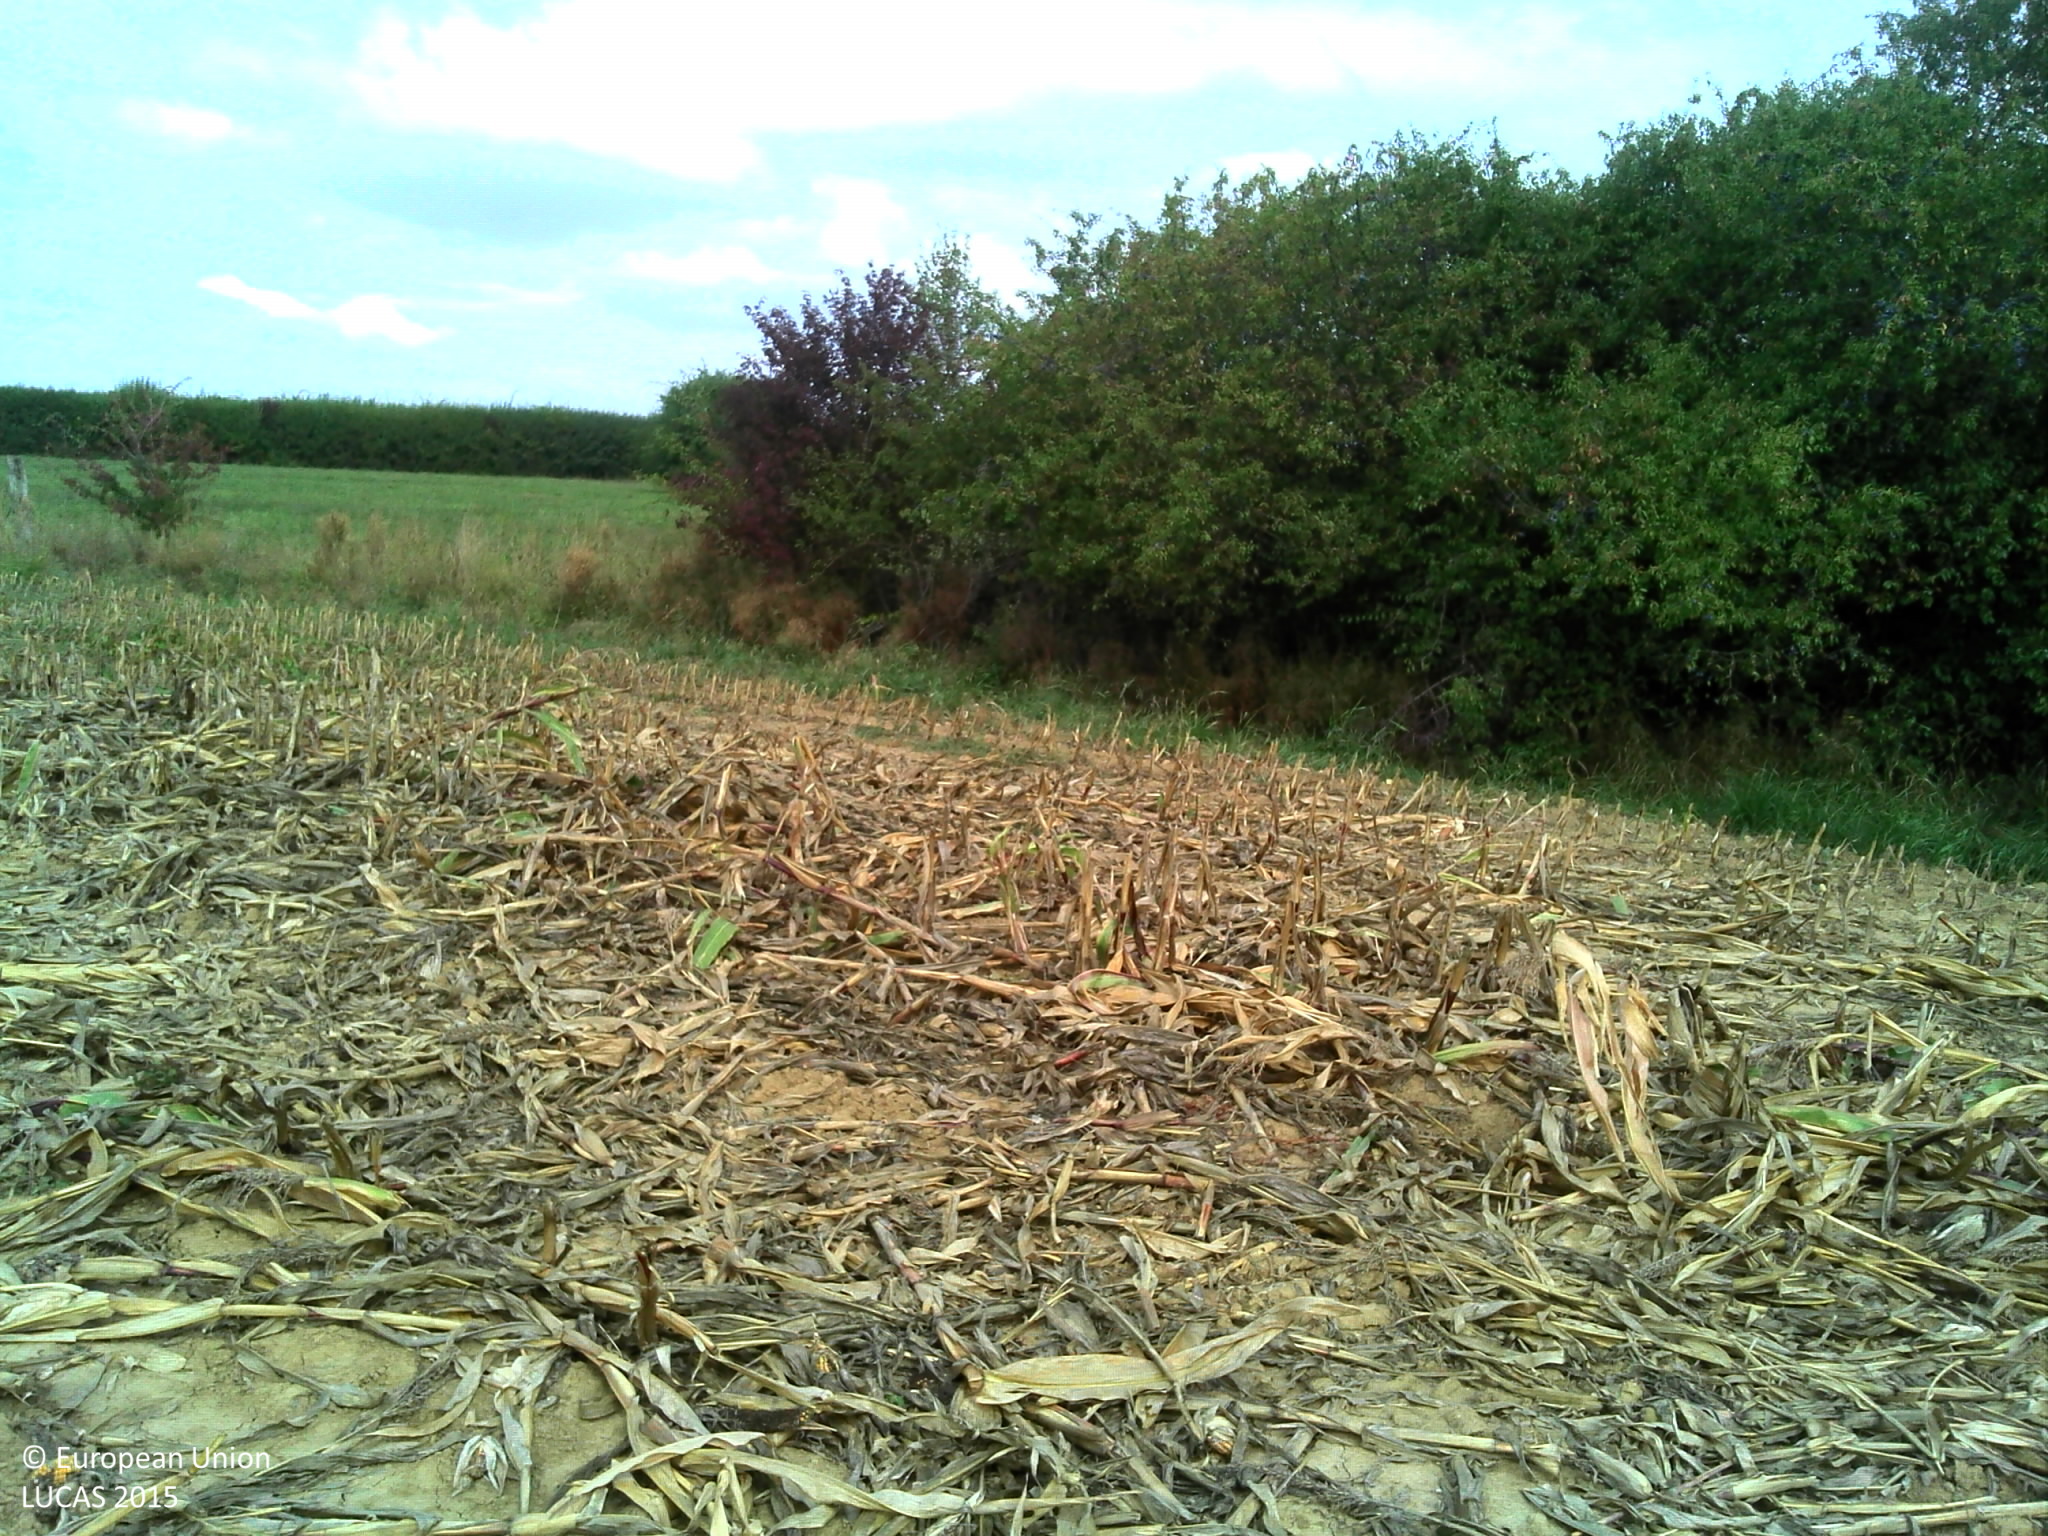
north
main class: Cropland
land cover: Maize
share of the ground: < 10 %
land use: Agriculture (excluding fallow land and kitchen gardens)
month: September
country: FR
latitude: 48.5494
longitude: 6.0579
